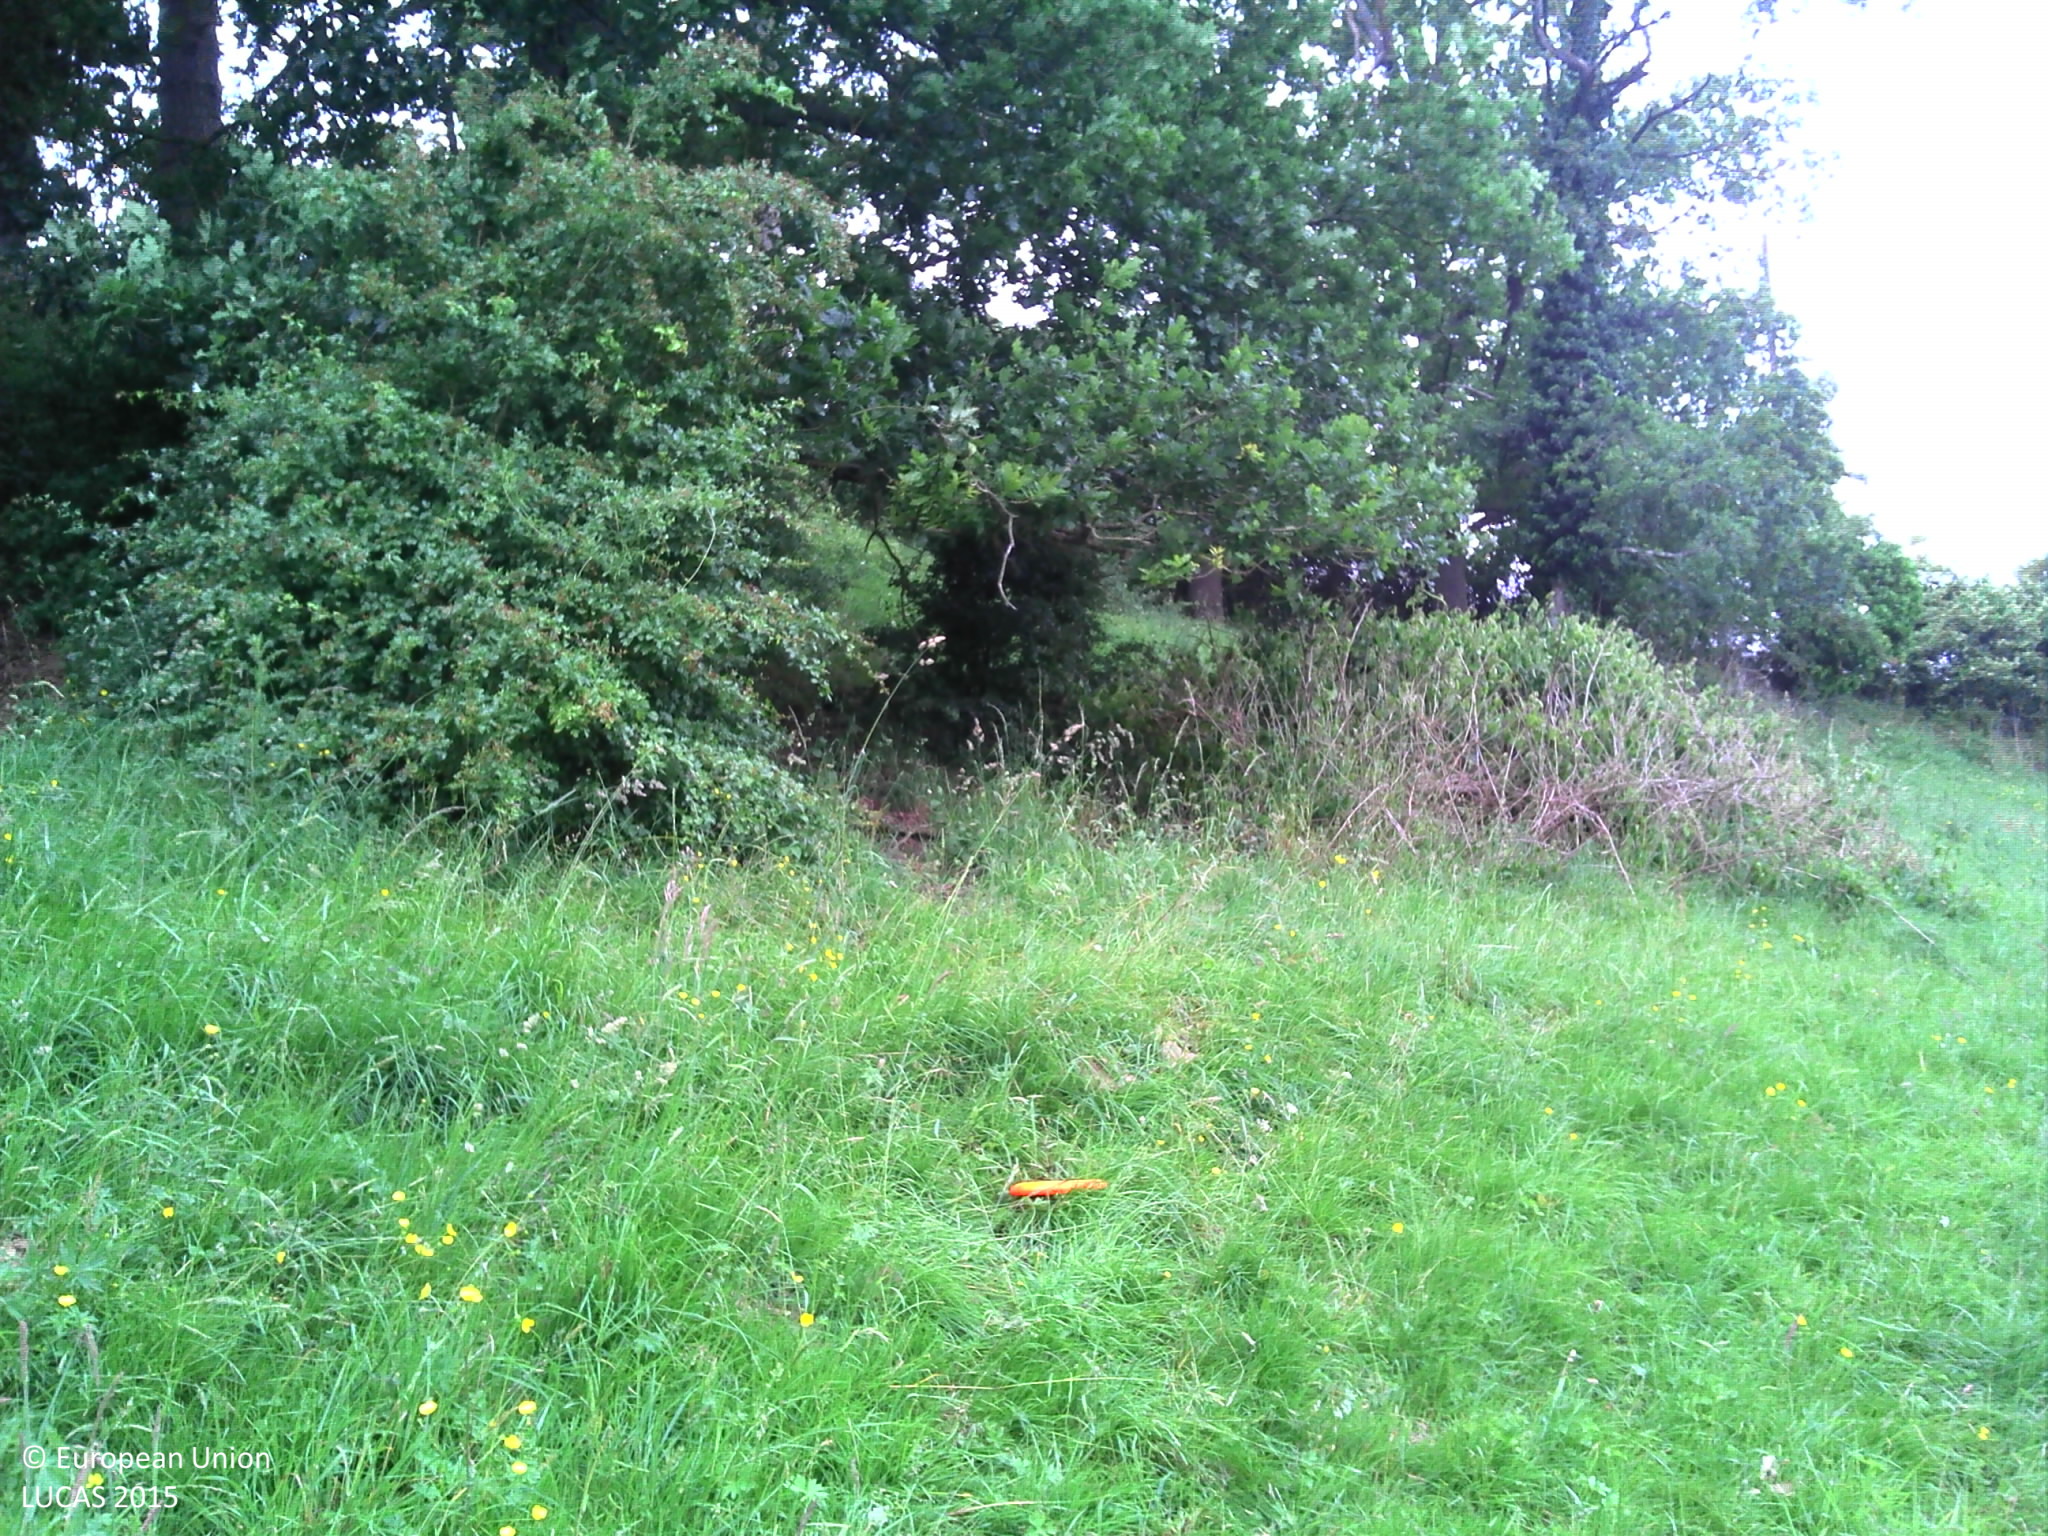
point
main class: Grassland
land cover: Grassland with sparse tree/shrub cover
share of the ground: > 75 %
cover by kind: herbaceous plants 95 %, broadleaved forest trees 5 %
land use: Agriculture (excluding fallow land and kitchen gardens)
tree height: > 5 m
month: June
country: FR
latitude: 48.2717
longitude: -0.0400
